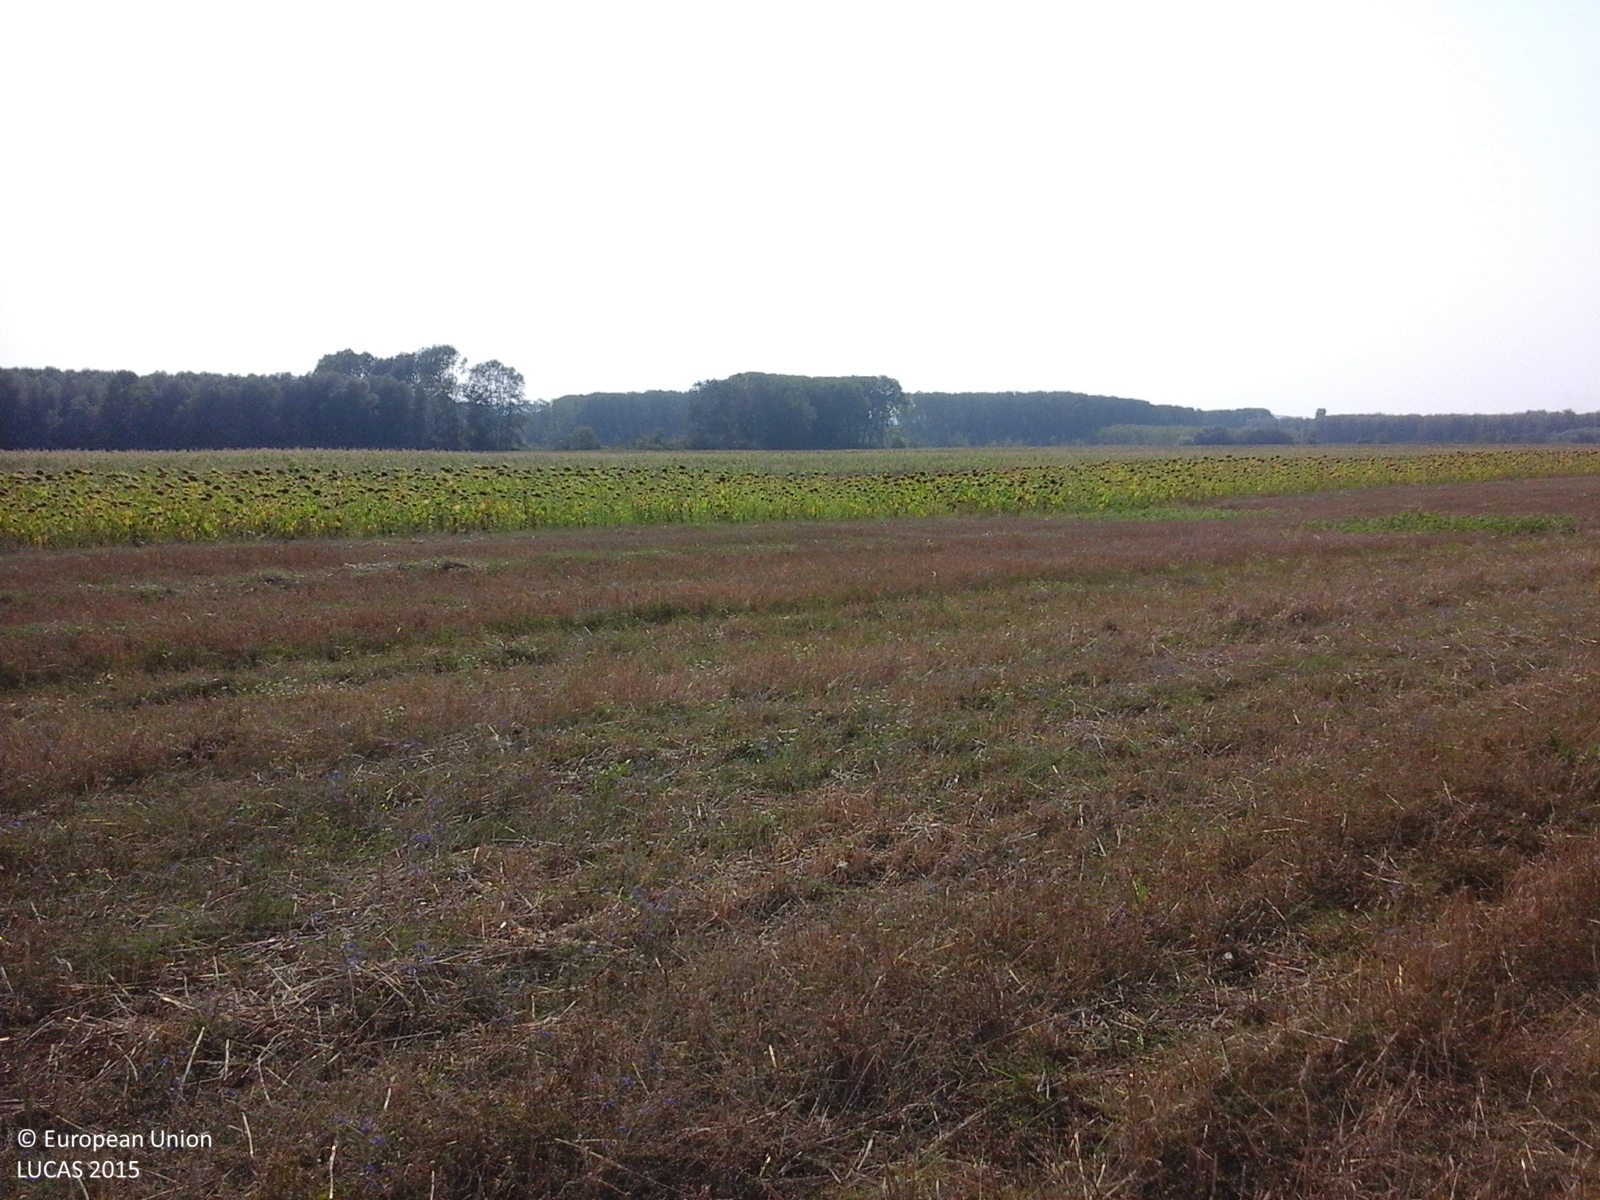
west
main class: Cropland
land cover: Common wheat
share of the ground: 50 - 75 %
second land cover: Spontaneously vegetated surfaces
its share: 25 - 50 %
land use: Agriculture (excluding fallow land and kitchen gardens)
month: August
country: RO
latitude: 44.5161
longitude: 23.5531
